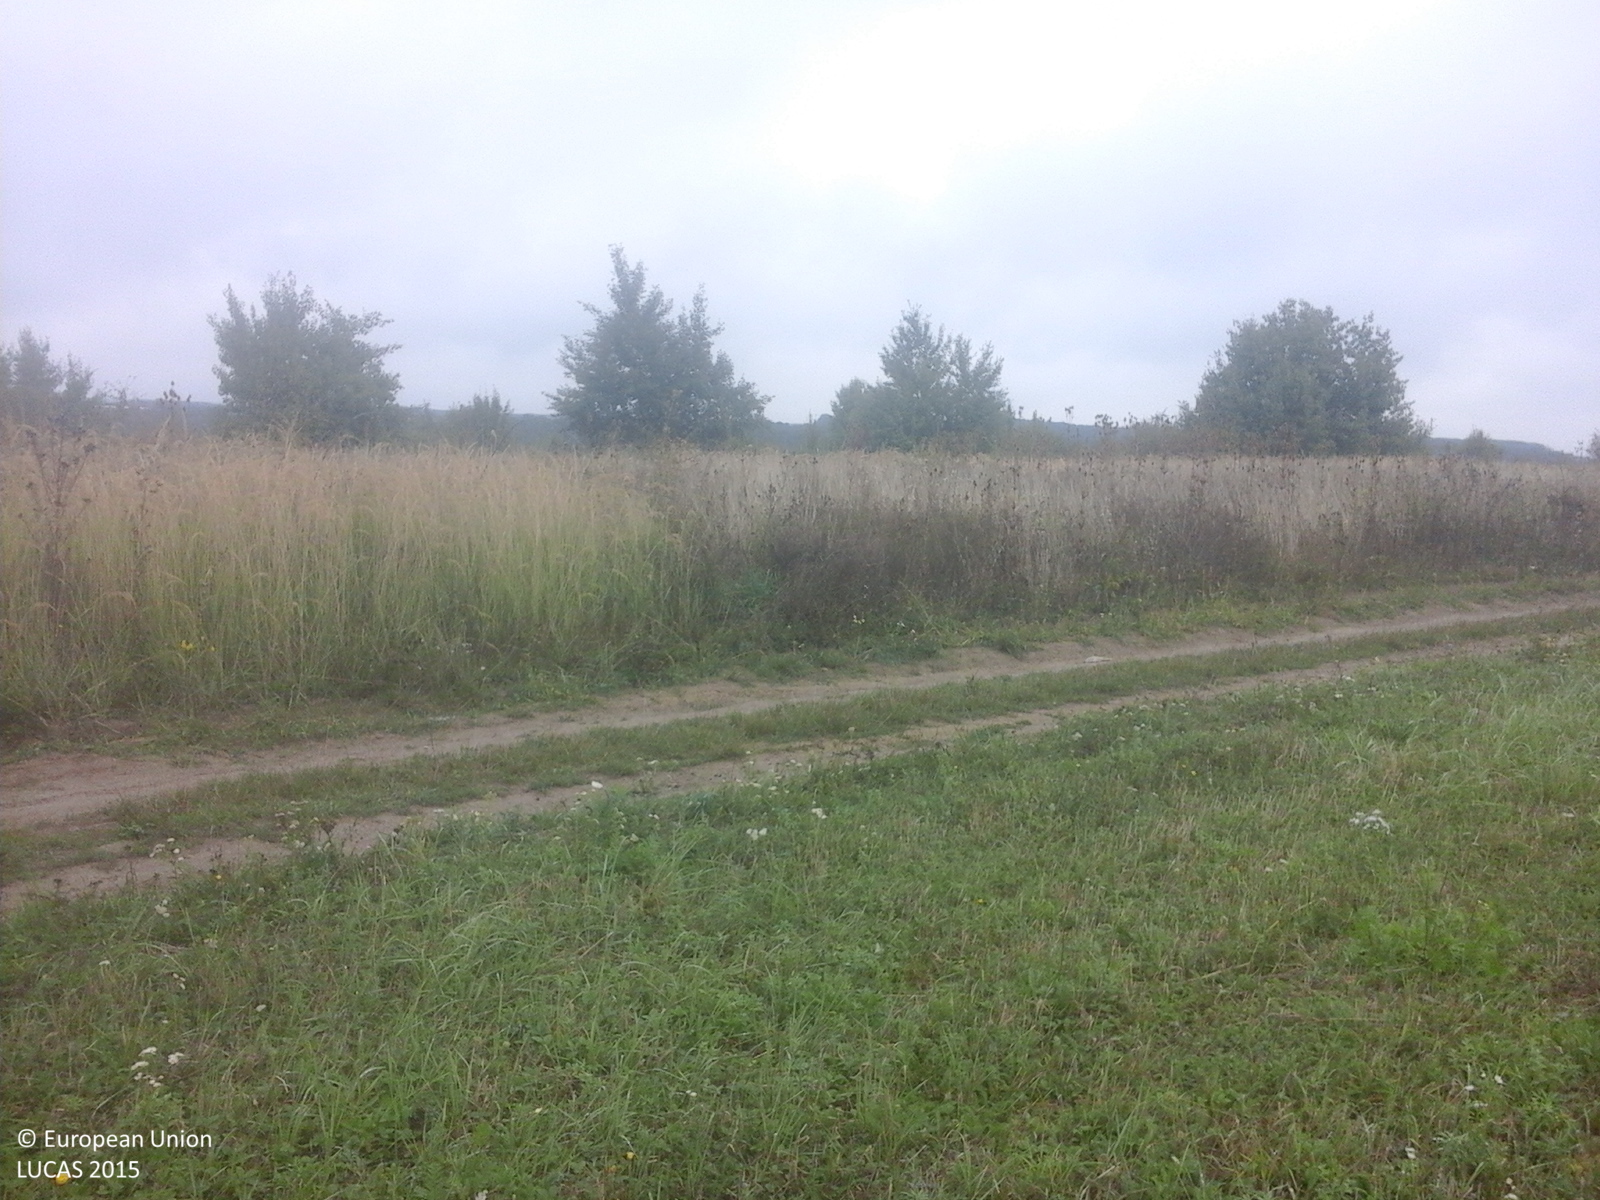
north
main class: Grassland
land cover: Grassland without tree/shrub cover
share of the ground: > 75 %
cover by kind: herbaceous plants 100 %
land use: Agriculture (excluding fallow land and kitchen gardens)
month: September
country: RO
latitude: 46.8151
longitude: 22.0386
